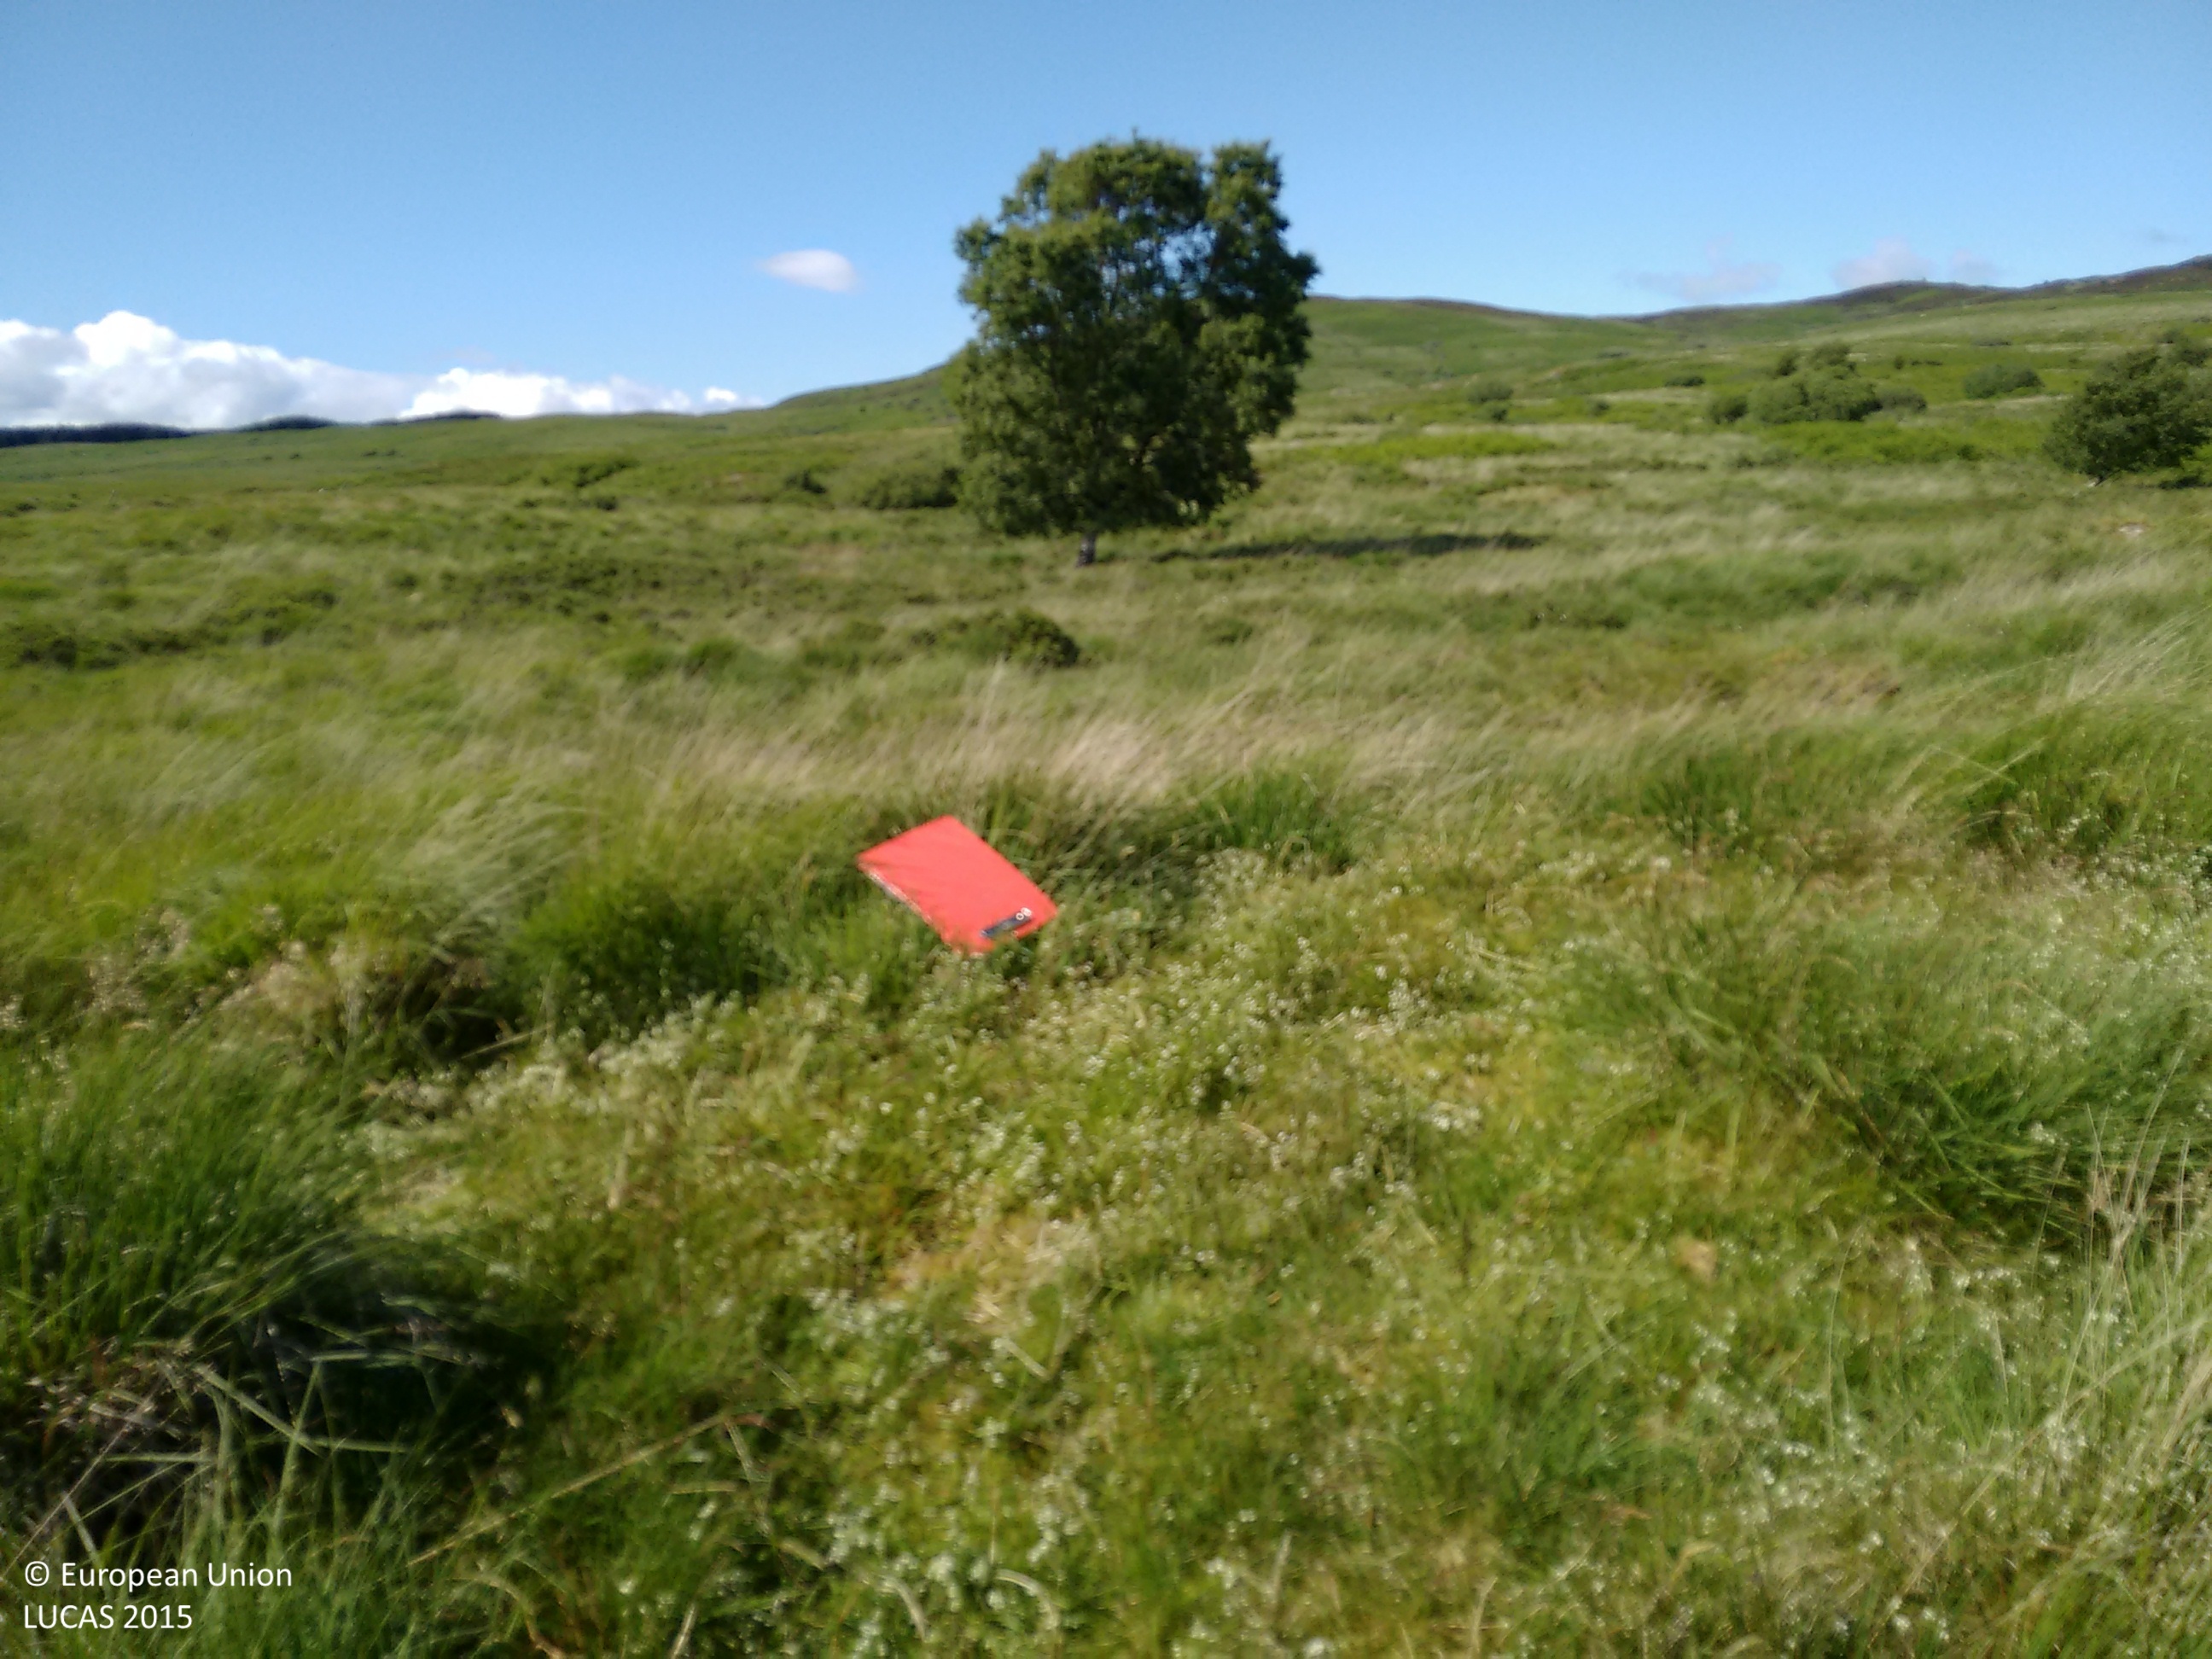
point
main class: Grassland
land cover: Grassland without tree/shrub cover
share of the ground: > 75 %
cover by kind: herbaceous plants 100 %
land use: Agriculture (excluding fallow land and kitchen gardens)
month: July
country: GB
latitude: 55.0981
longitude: -4.0548
